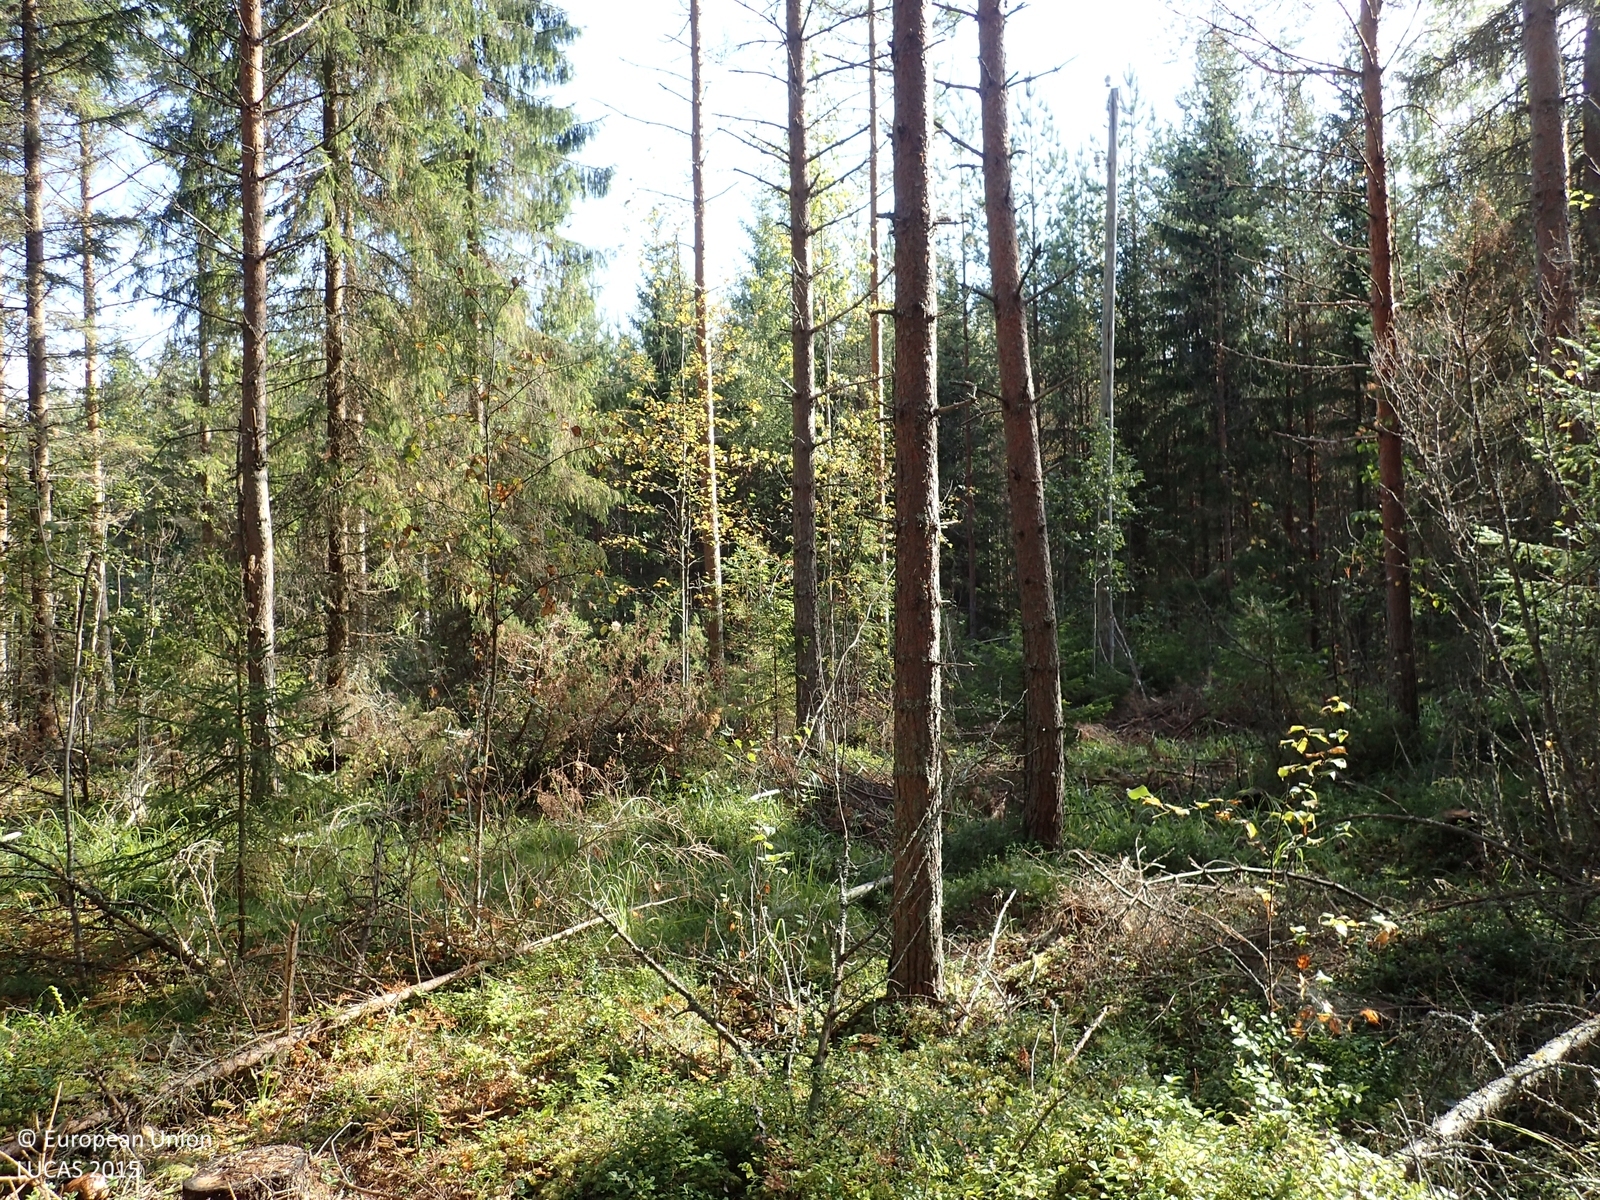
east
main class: Woodland
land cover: Other coniferous woodland
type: boreal forest
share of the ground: > 75 %
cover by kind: coniferous forest trees 65 %, shrubs 15 %, broadleaved forest trees 10 %, herbaceous plants 10 %
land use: Forestry
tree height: > 5 m
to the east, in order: Other coniferous woodland; Electric lines; Other mixed woodland; Ditches and canals; Other mixed woodland; Ditches and canals; Other mixed woodland; Ditches and canals; Other mixed woodland; Ditches and canals; Spruce dominated mixed woodland; Ditches and canals; Pine dominated mixed woodland
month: September
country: FI
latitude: 63.1701
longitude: 25.6585
